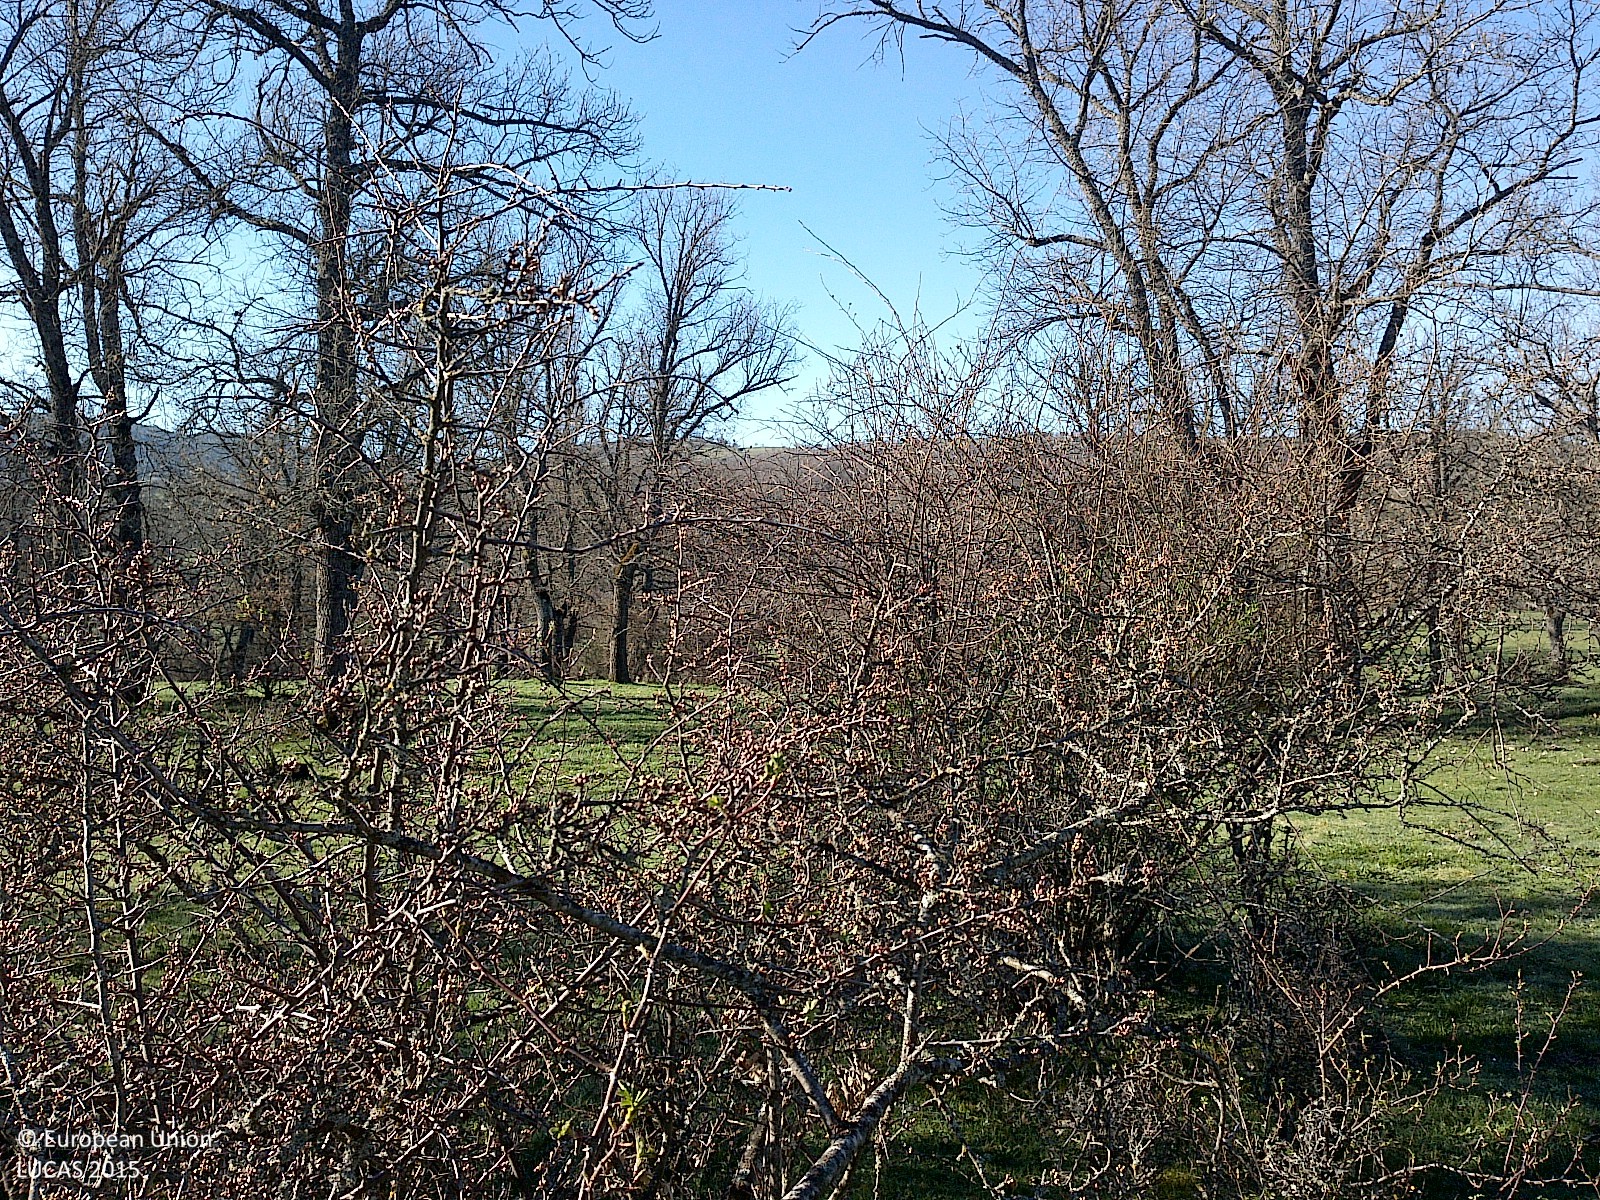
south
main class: Woodland
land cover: Broadleaved woodland
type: thermophilous deciduous forest
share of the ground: 10 - 25 %
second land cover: Spontaneously vegetated surfaces
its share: > 75 %
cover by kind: herbaceous plants 80 %, broadleaved forest trees 10 %, shrubs 10 %
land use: Forestry
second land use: Agriculture (excluding fallow land and kitchen gardens)
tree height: > 5 m
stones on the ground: < 10 %
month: April
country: ES
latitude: 41.9648
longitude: -3.0913
